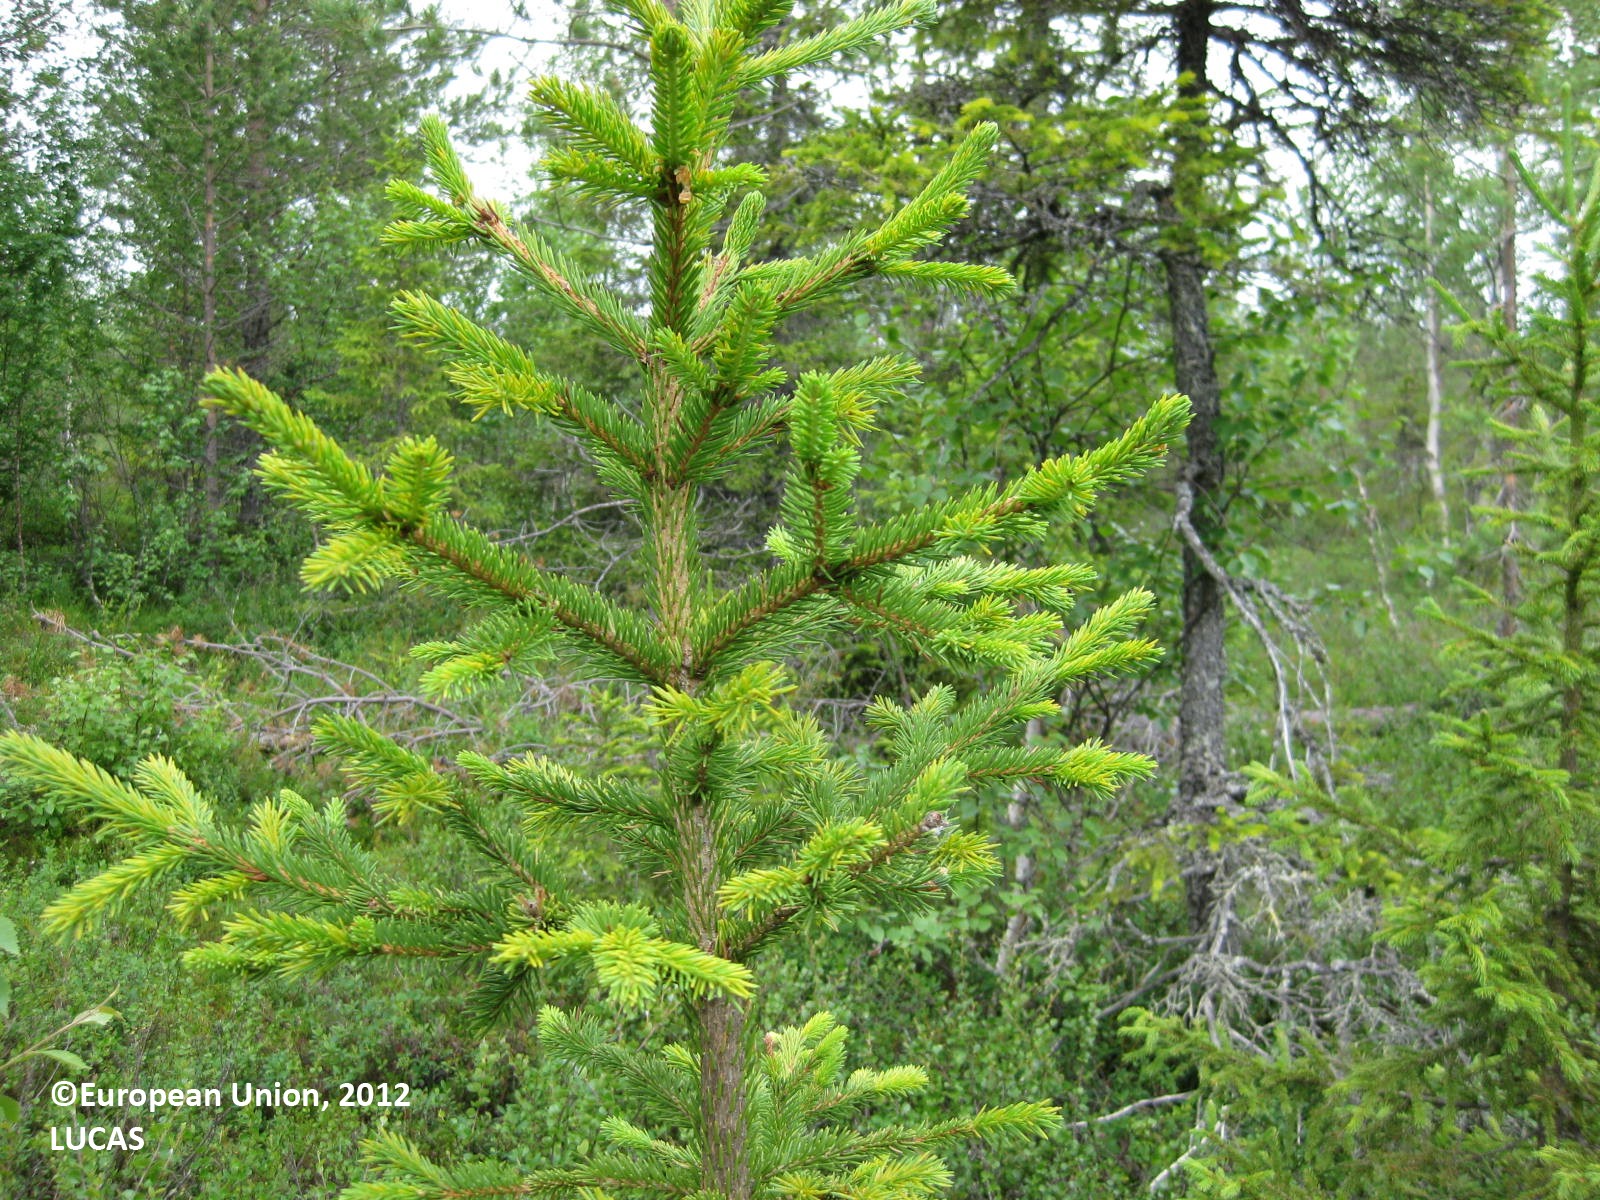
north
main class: Woodland
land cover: Other mixed woodland
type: boreal forest
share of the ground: 25 - 50 %
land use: Forestry
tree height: > 5 m
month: July
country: FI
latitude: 65.4216
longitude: 28.3651
